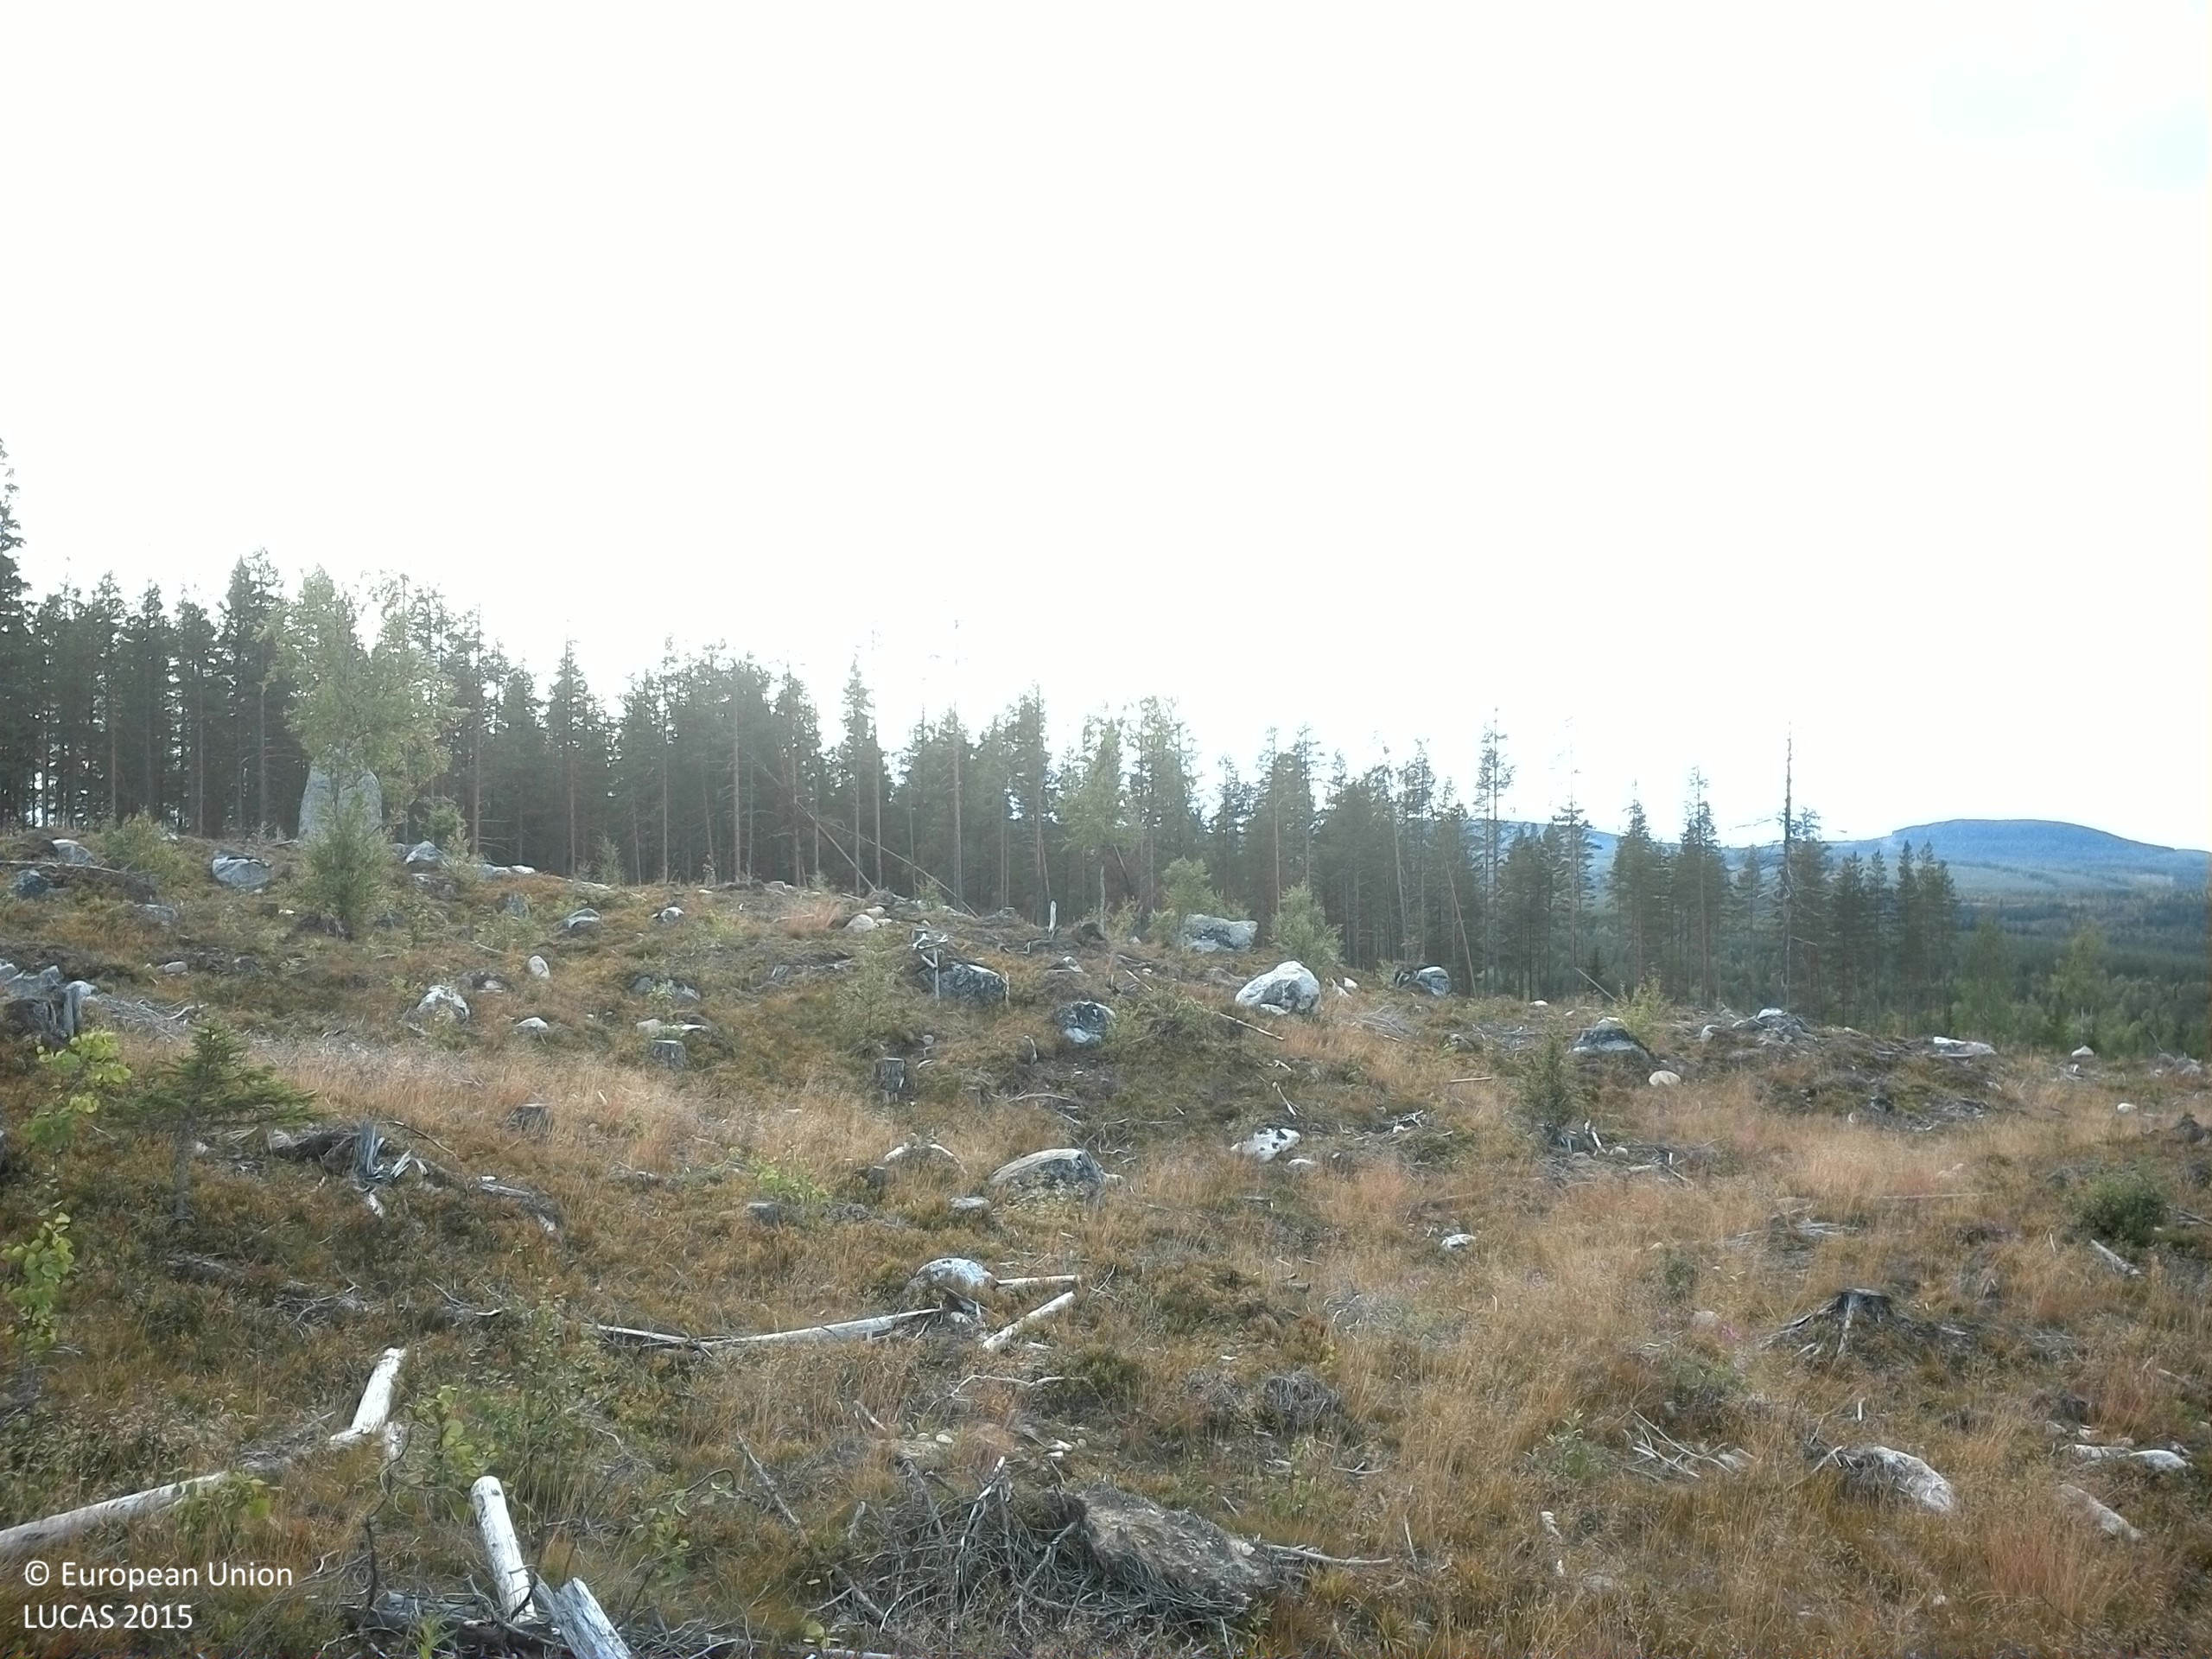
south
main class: Shrubland
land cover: Shrubland with sparse tree cover
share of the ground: 50 - 75 %
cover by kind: shrubs 60 %, herbaceous plants 20 %, lichens and mosses 10 %, broadleaved forest trees 5 %, unconsolidated bare surface 5 %
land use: Forestry
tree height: < 5 m
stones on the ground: > 50 %
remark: Clear cut
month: September
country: SE
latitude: 64.1655
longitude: 17.5178
